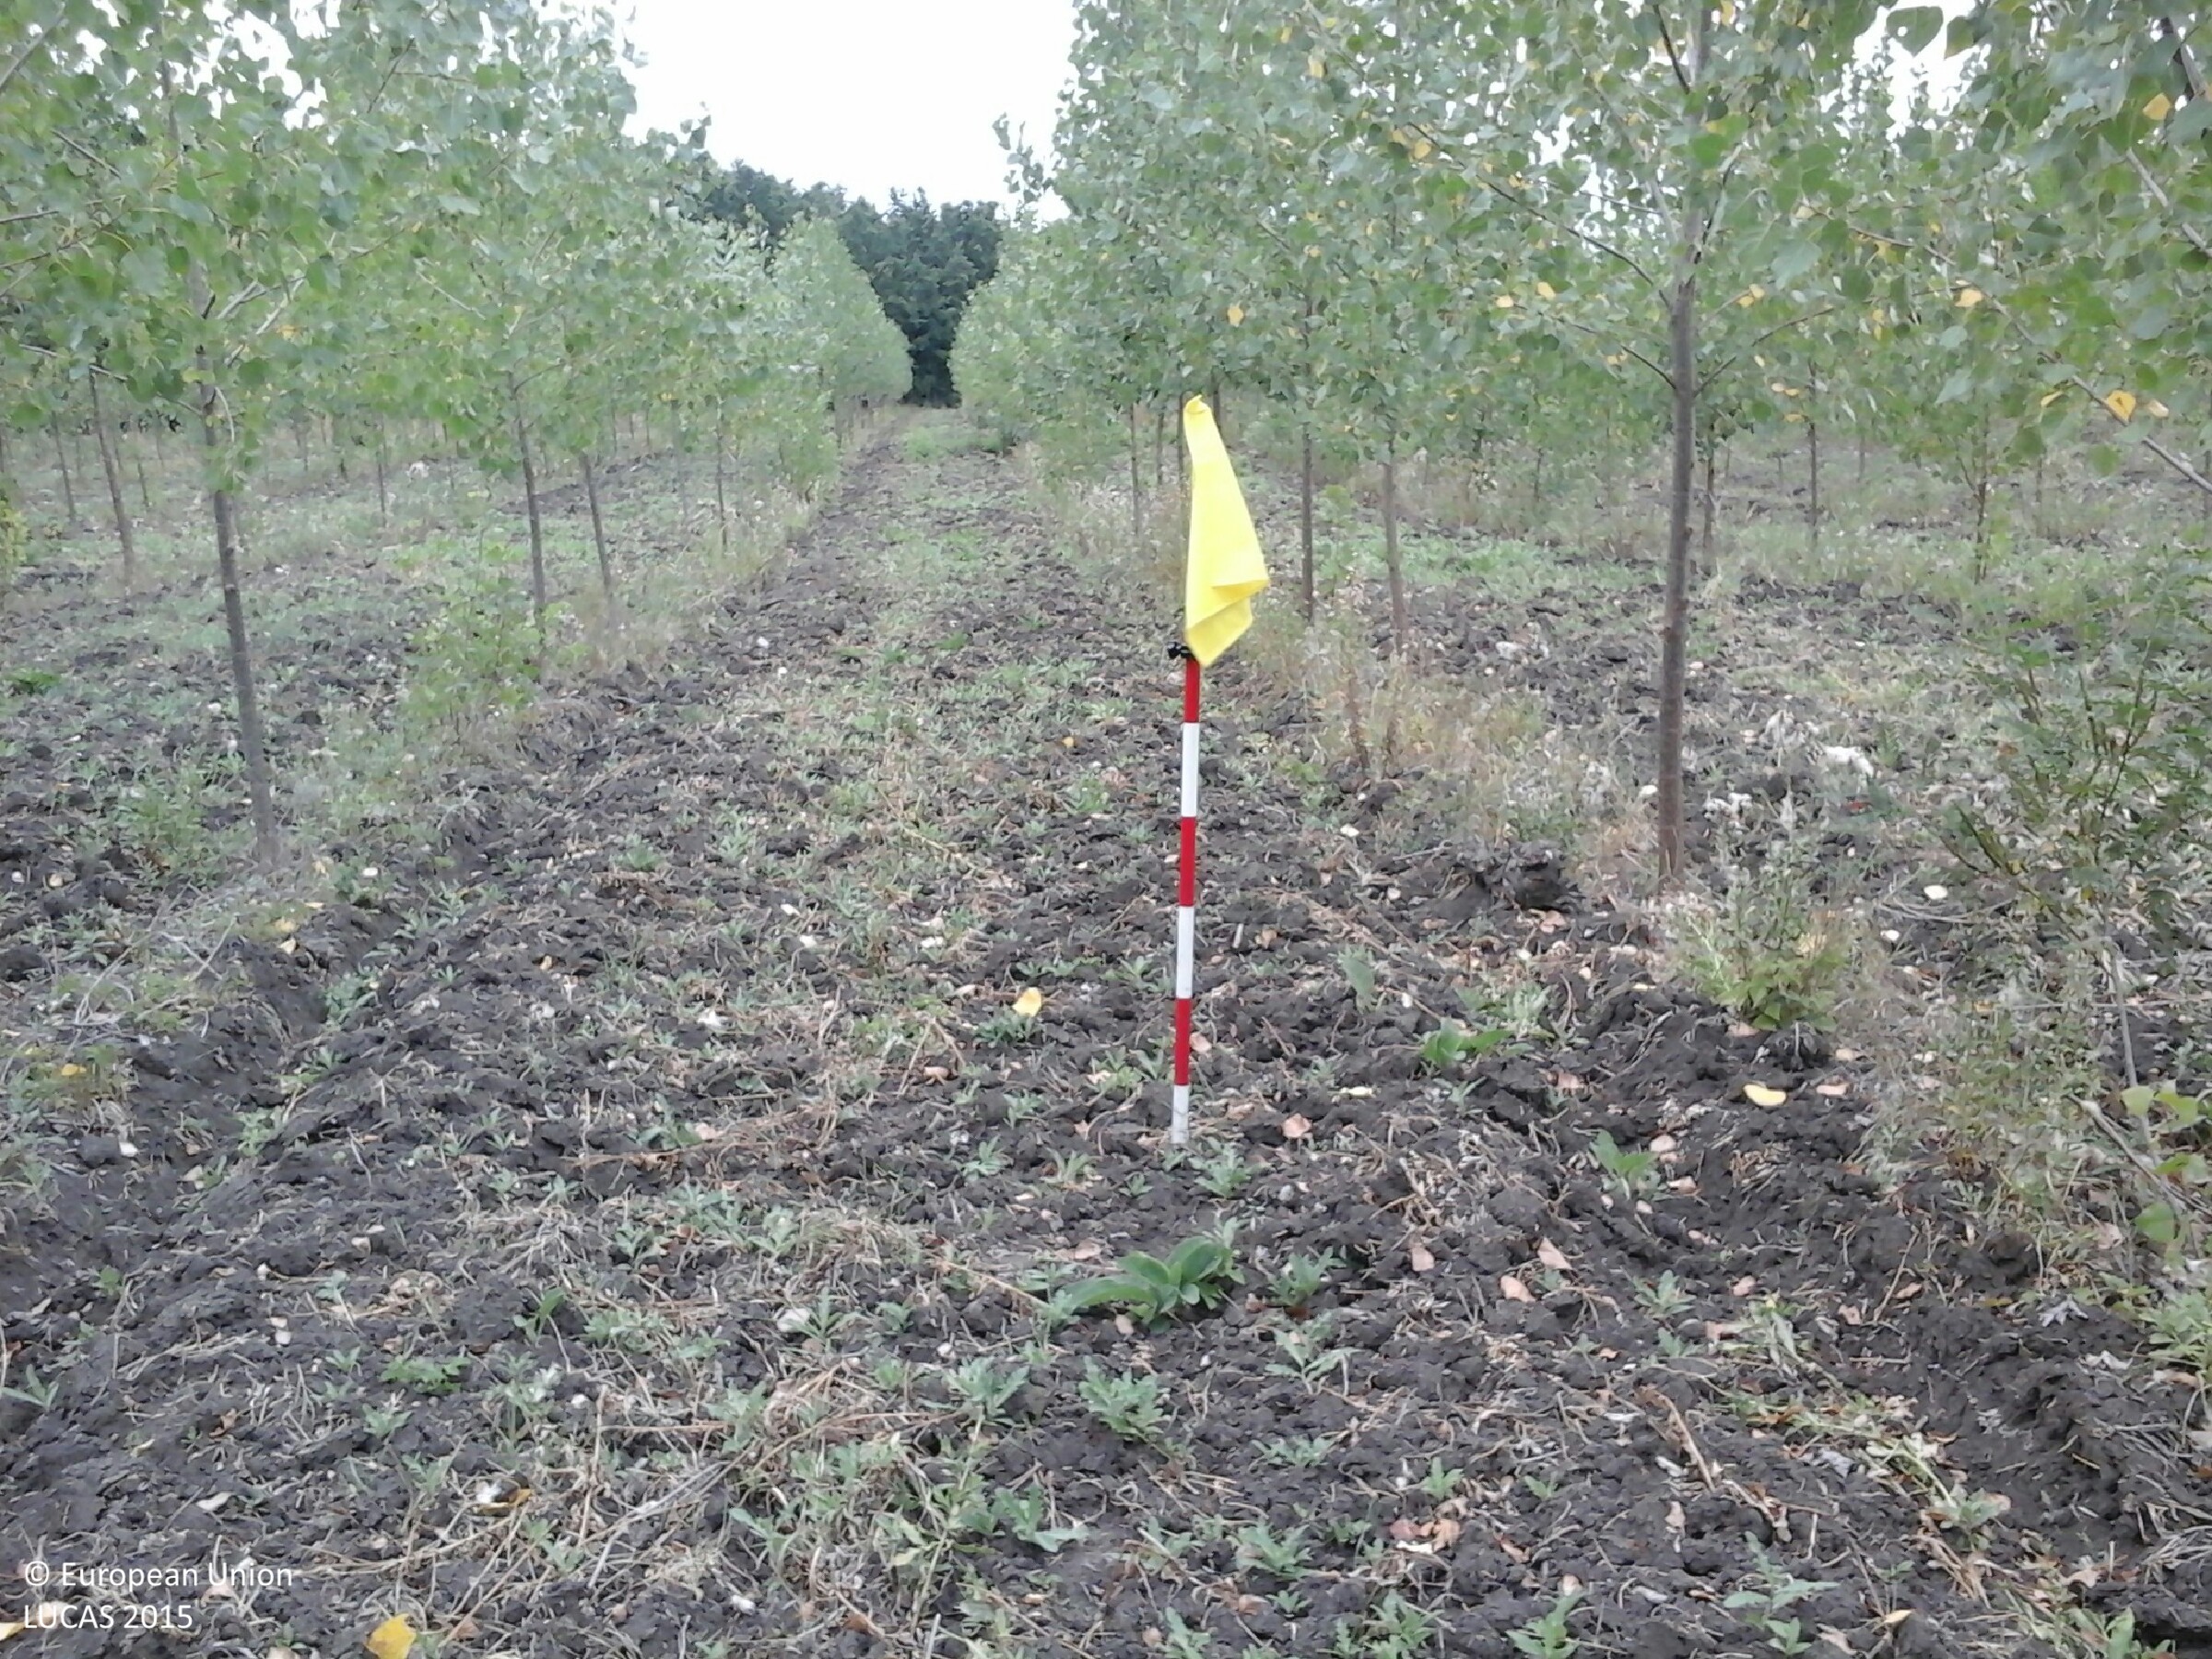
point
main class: Woodland
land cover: Broadleaved woodland
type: non-riverine alder, birch or aspen forest
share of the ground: 50 - 75 %
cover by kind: broadleaved forest trees 50 %, unconsolidated bare surface 35 %, herbaceous plants 15 %
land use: Forestry
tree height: < 5 m
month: July
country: HU
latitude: 47.4617
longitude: 20.5510
